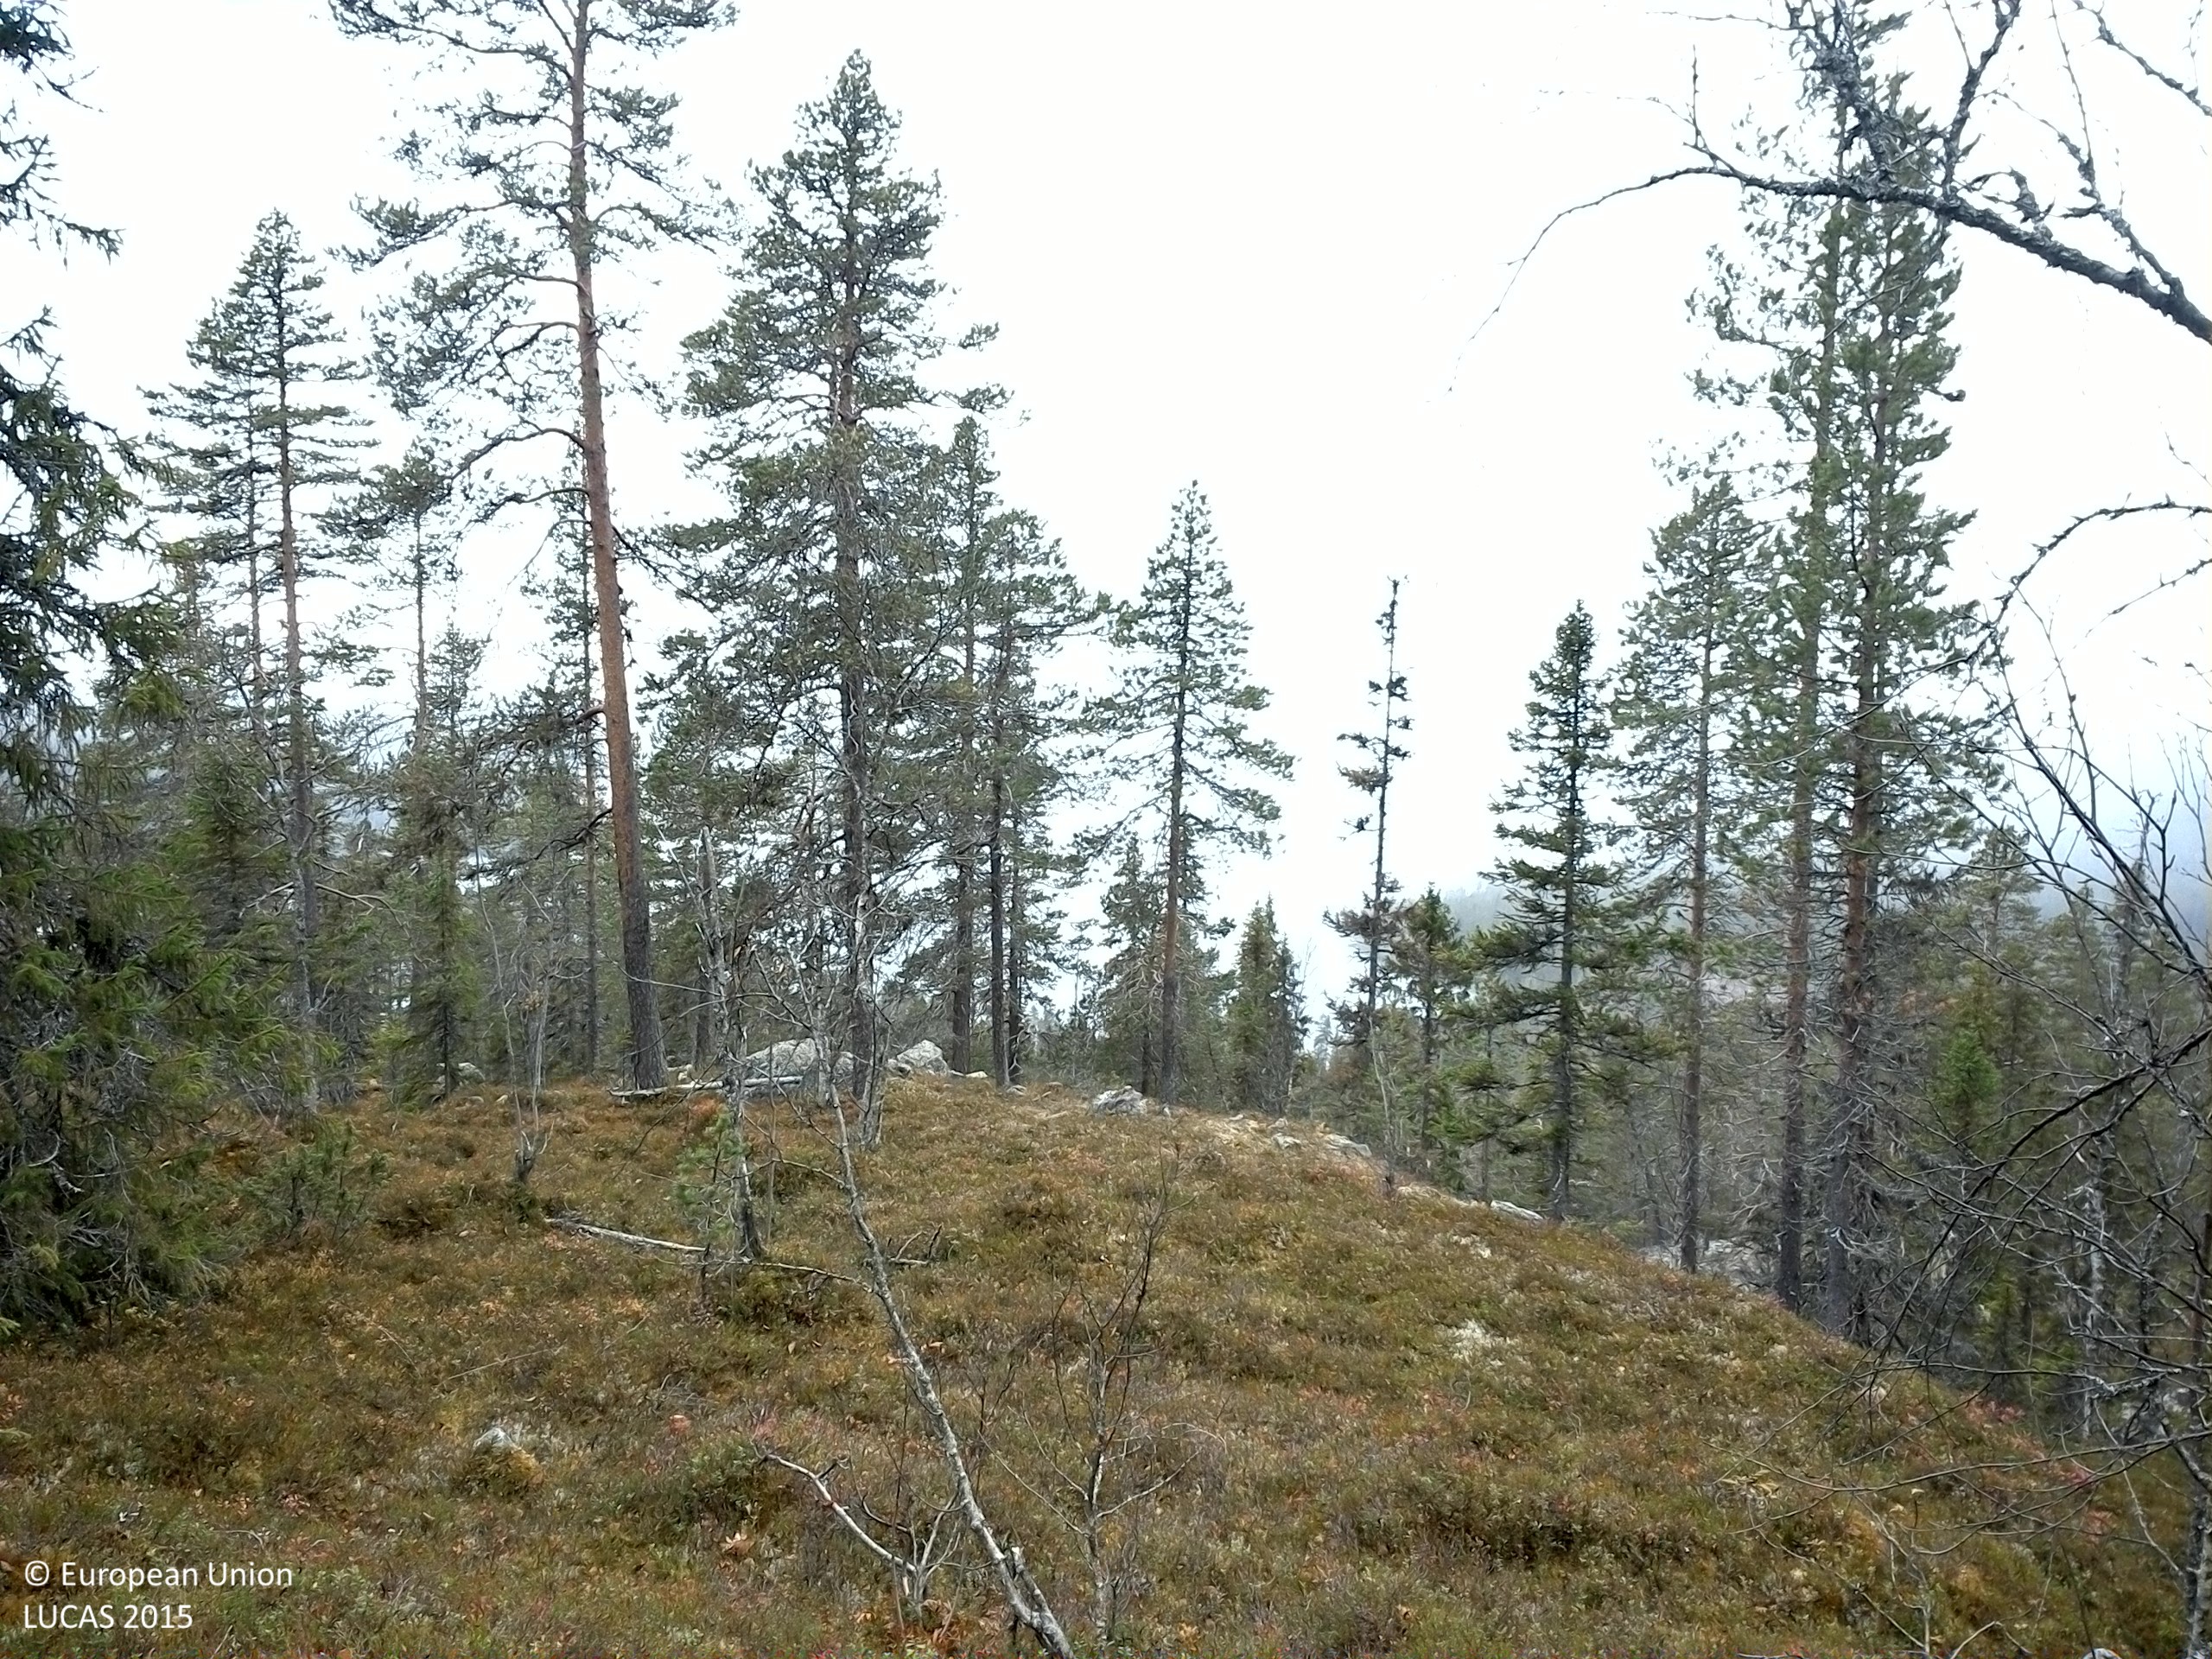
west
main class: Woodland
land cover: Other mixed woodland
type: boreal forest
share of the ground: 25 - 50 %
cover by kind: shrubs 30 %, coniferous forest trees 25 %, consolidated bare surface 20 %, lichens and mosses 15 %, broadleaved forest trees 10 %
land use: Forestry
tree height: > 5 m
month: October
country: SE
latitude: 64.4194
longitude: 15.2644
